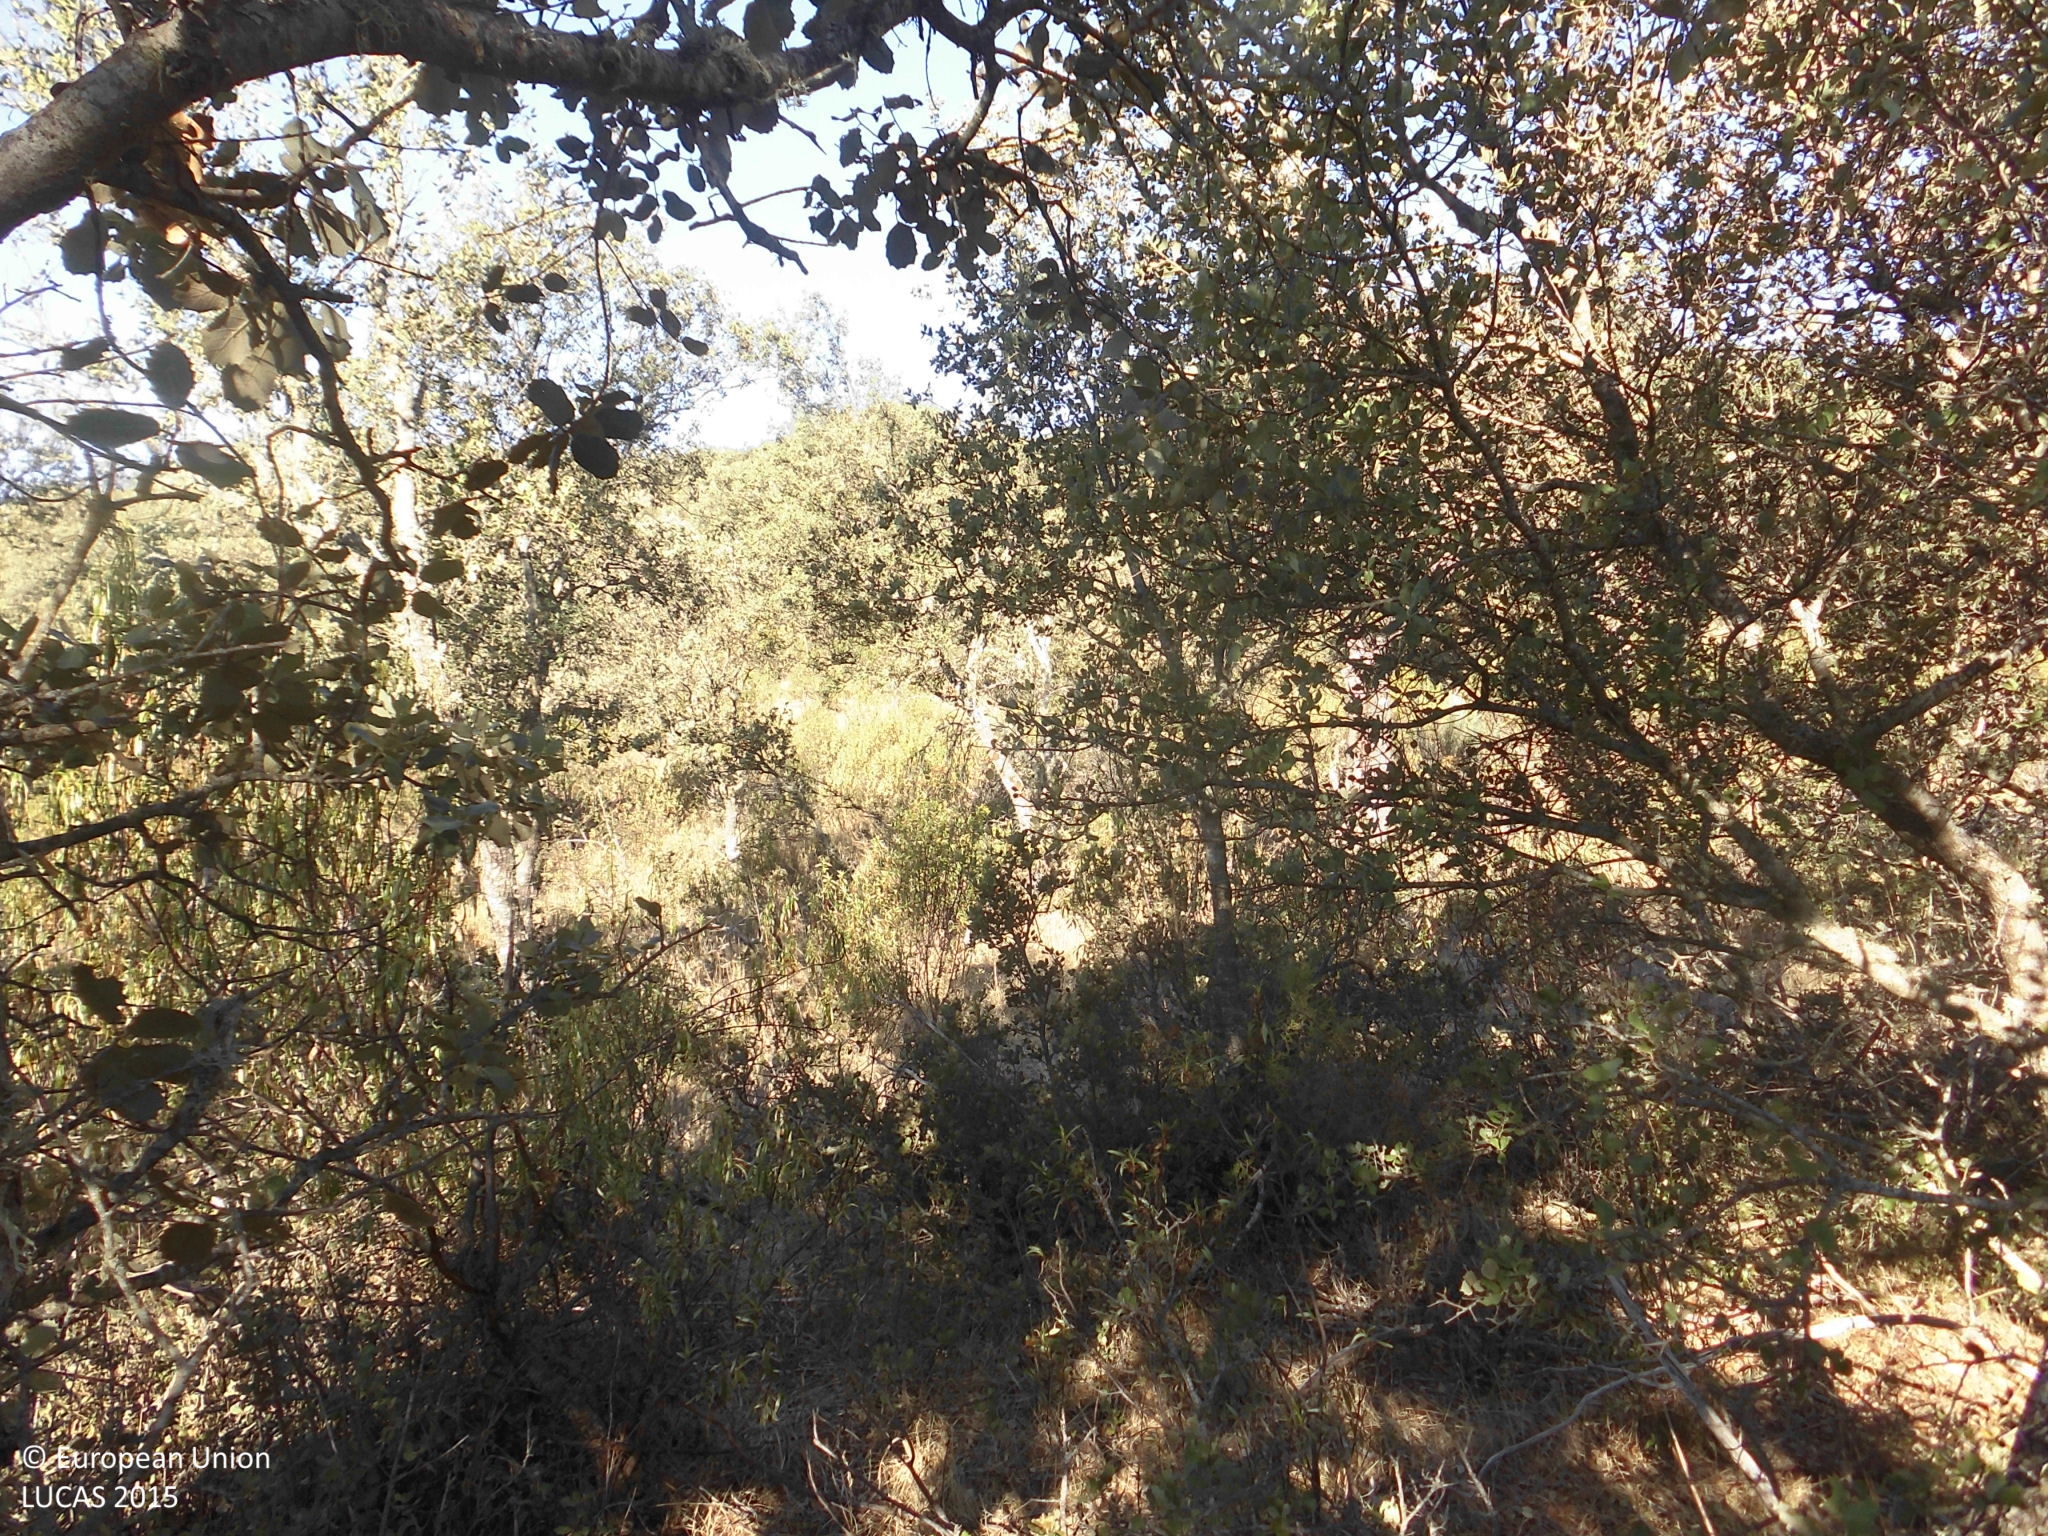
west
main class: Woodland
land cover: Broadleaved woodland
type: broadleaved evergreen forest
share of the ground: 25 - 50 %
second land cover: Shrubland without tree cover
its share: 10 - 25 %
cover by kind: broadleaved forest trees 45 %, herbaceous plants 35 %, shrubs 20 %
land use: Forestry
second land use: Agriculture (excluding fallow land and kitchen gardens)
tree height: > 5 m
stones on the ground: 10 - 25 %
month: July
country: ES
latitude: 39.7860
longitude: -5.6954
